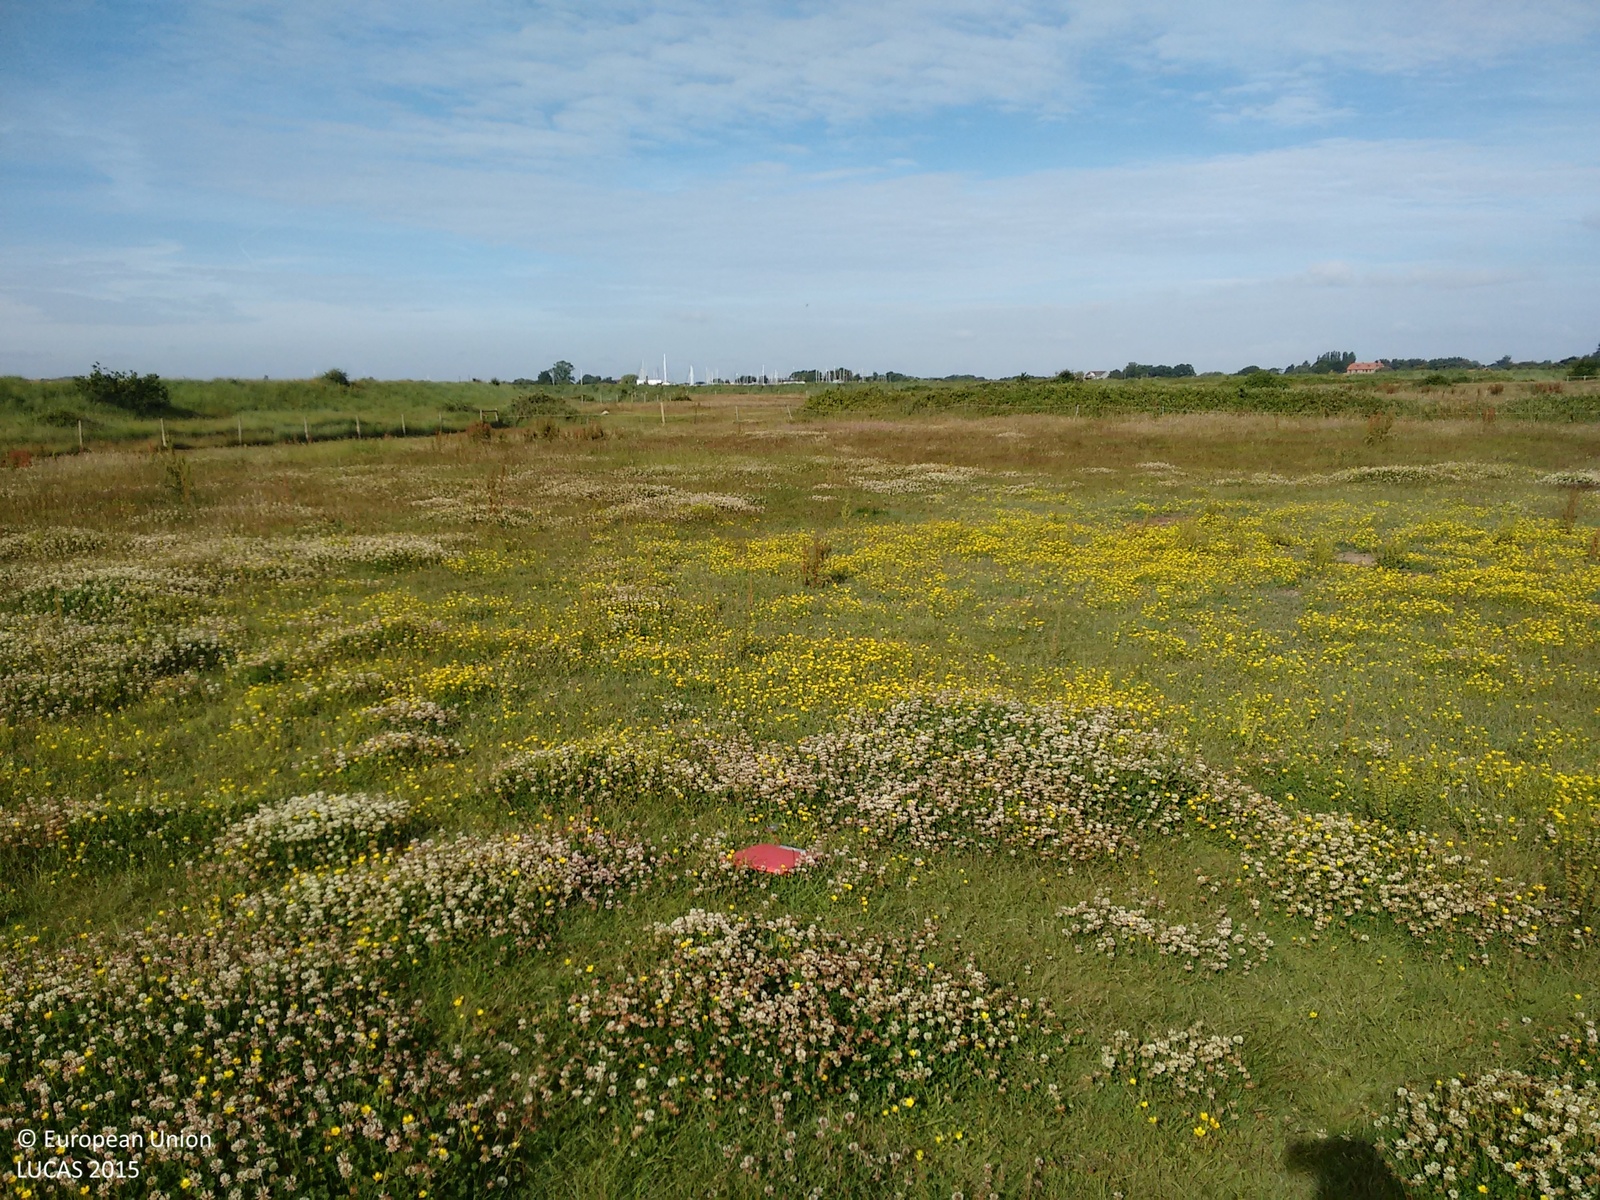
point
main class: Grassland
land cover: Grassland without tree/shrub cover
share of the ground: > 75 %
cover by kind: herbaceous plants 100 %
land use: Agriculture (excluding fallow land and kitchen gardens)
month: June
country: GB
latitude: 50.8389
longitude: -0.9065
